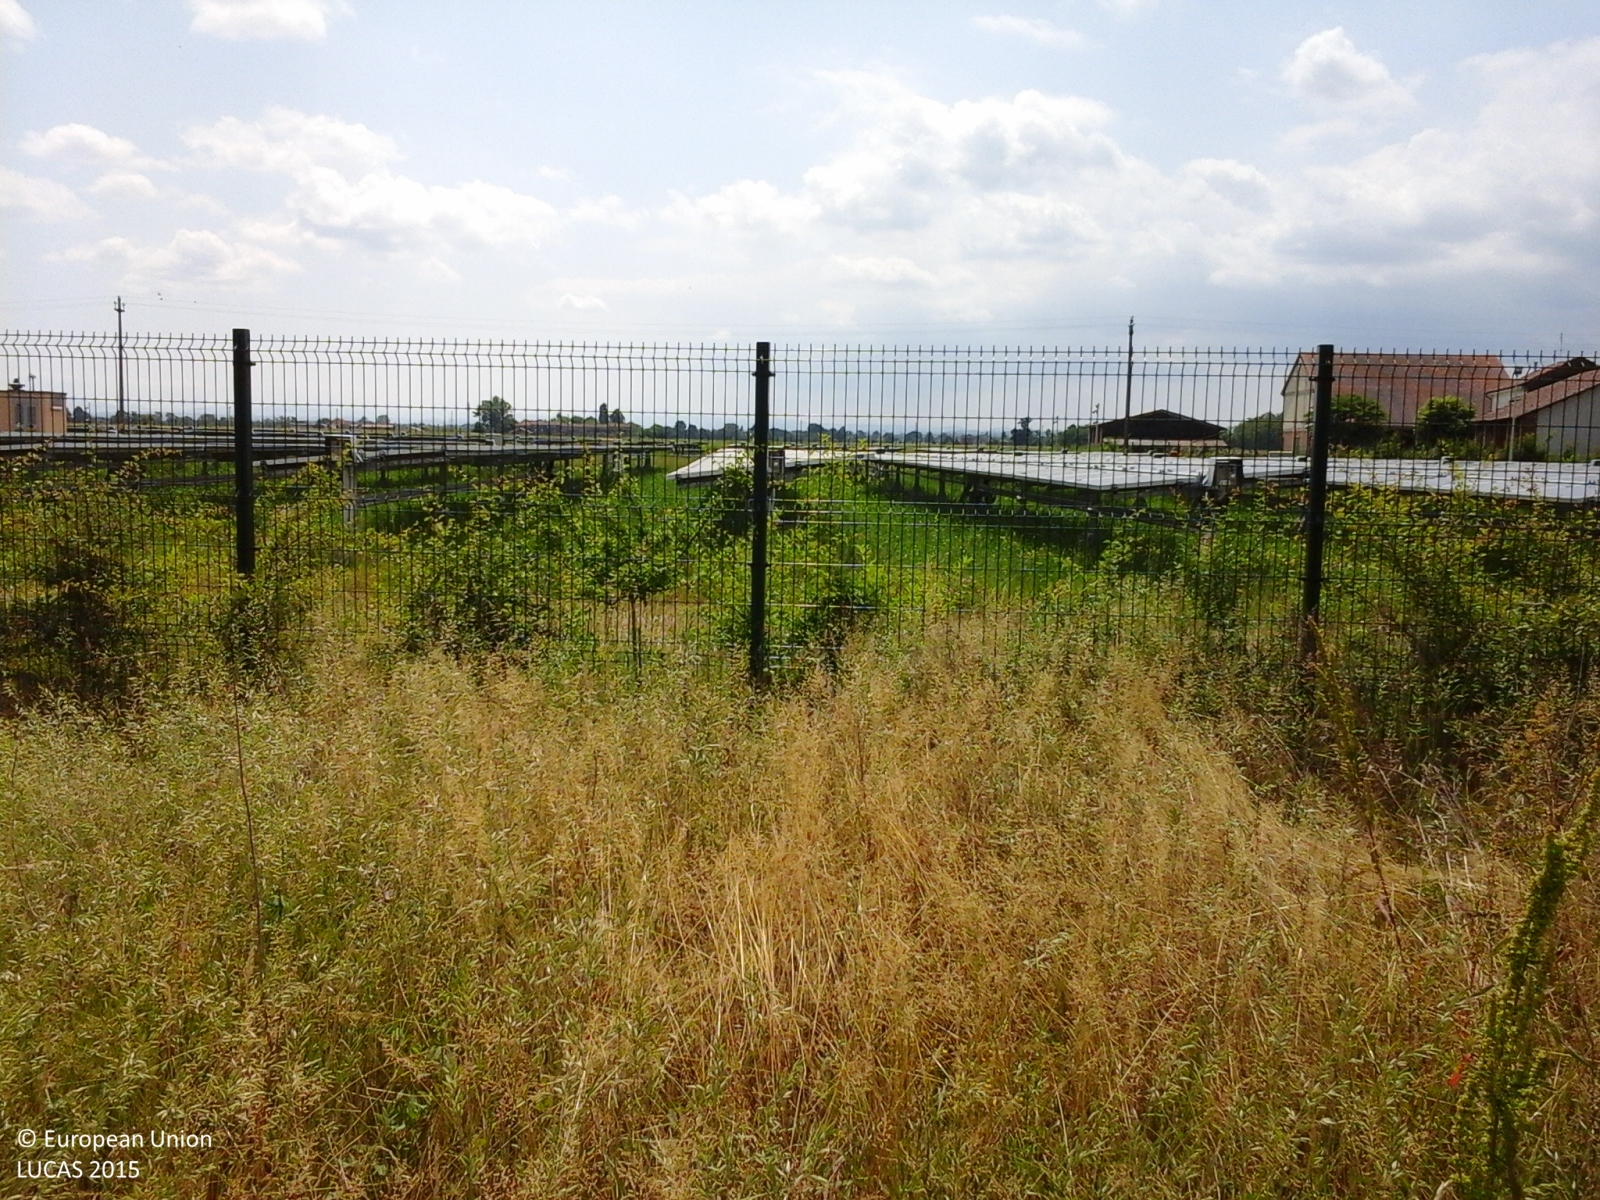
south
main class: Grassland
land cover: Spontaneously vegetated surfaces
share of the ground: > 75 %
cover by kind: herbaceous plants 100 %
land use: Fallow land
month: May
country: IT
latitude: 44.8631
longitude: 8.5222
